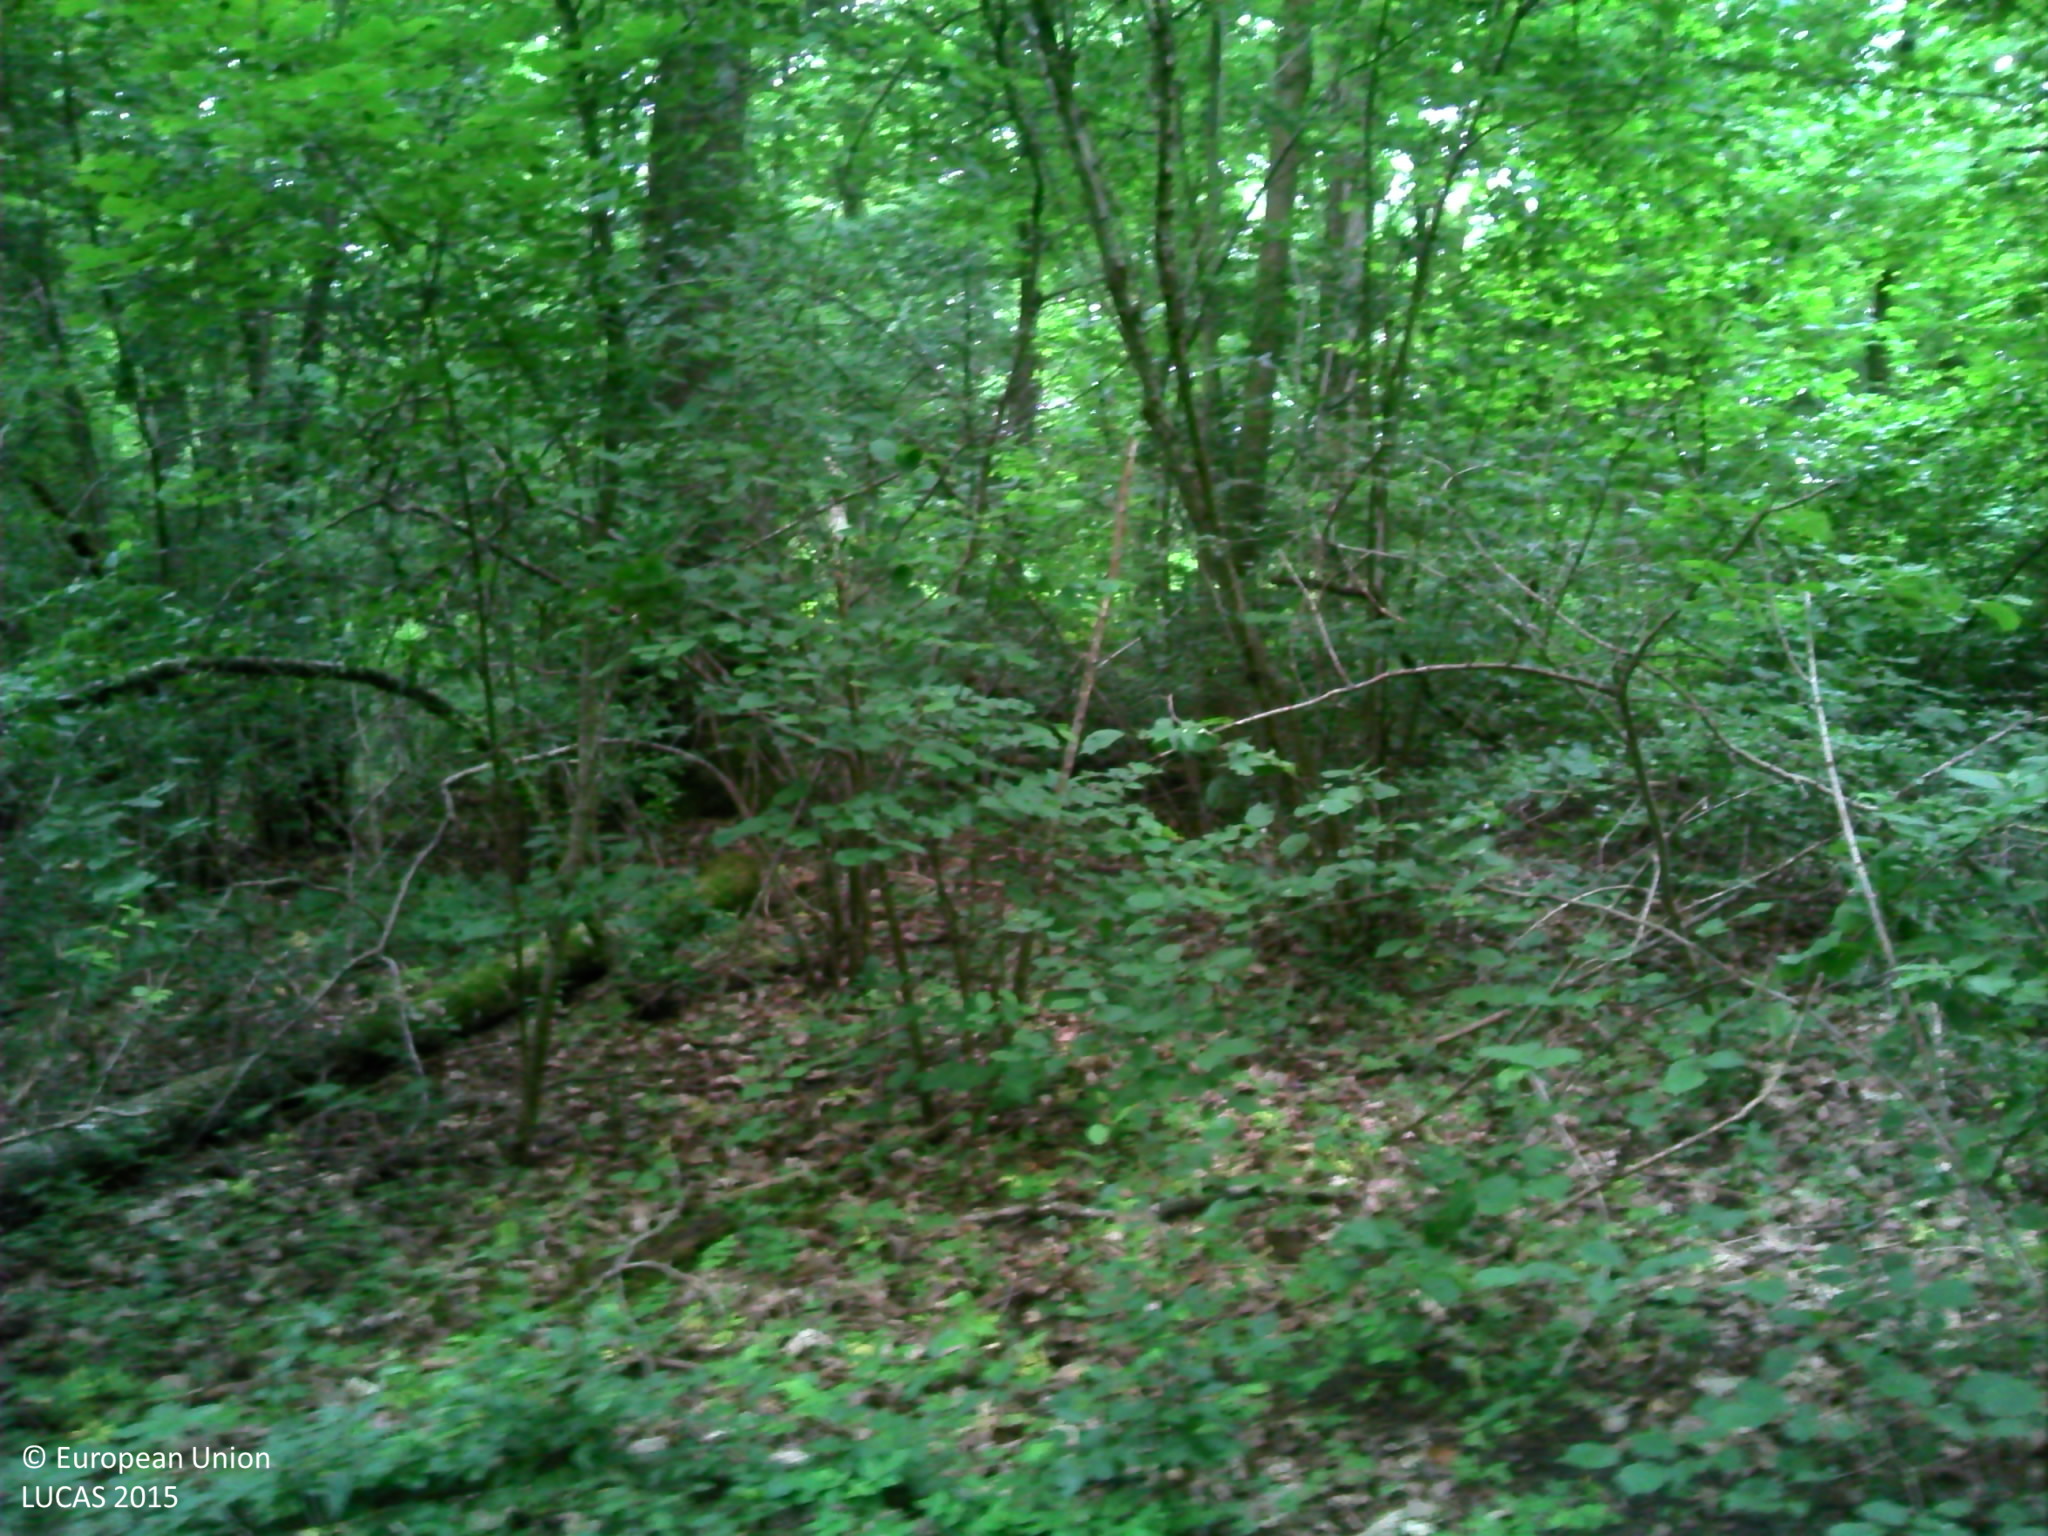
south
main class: Woodland
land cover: Broadleaved woodland
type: mesophytic deciduous forest
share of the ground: > 75 %
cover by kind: broadleaved forest trees 90 %, herbaceous plants 5 %, lichens and mosses 5 %
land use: Forestry
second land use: Amenities, museums, leisure
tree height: > 5 m
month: June
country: FR
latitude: 48.5937
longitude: 6.2987
